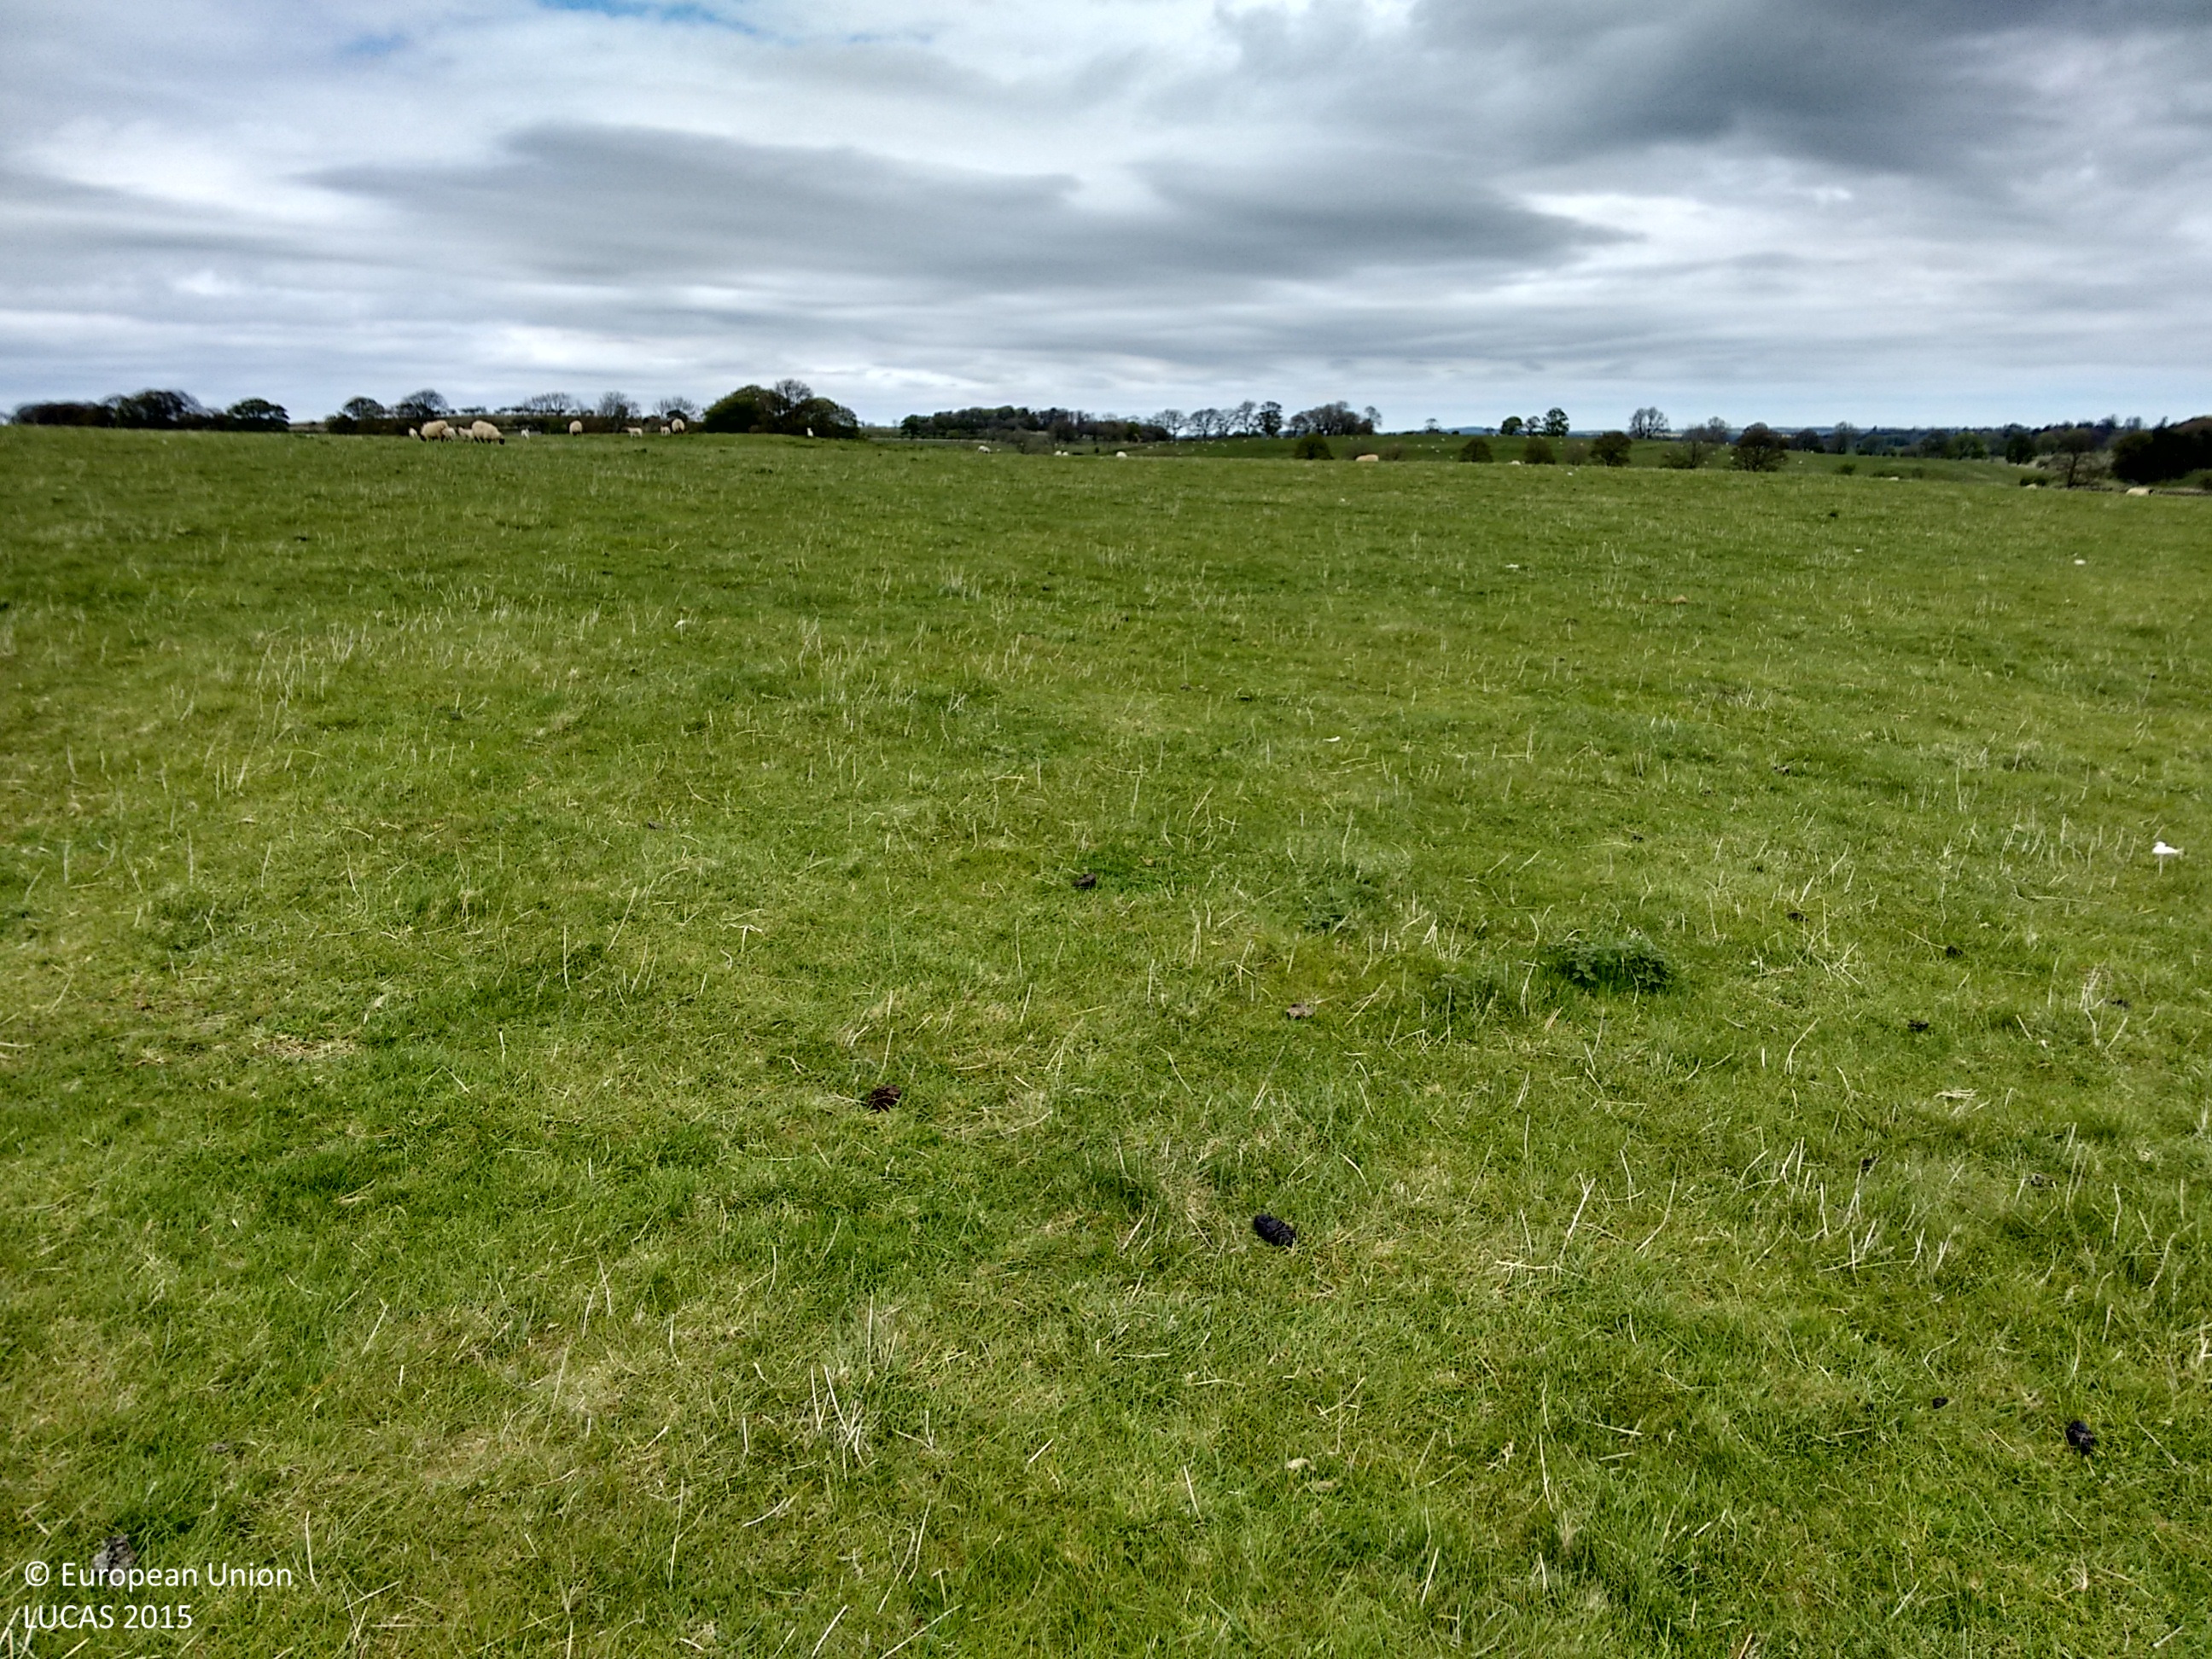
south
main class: Grassland
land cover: Grassland without tree/shrub cover
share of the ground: > 75 %
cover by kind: herbaceous plants 100 %
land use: Agriculture (excluding fallow land and kitchen gardens)
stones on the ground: < 10 %
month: May
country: GB
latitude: 55.1289
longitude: -2.0209
